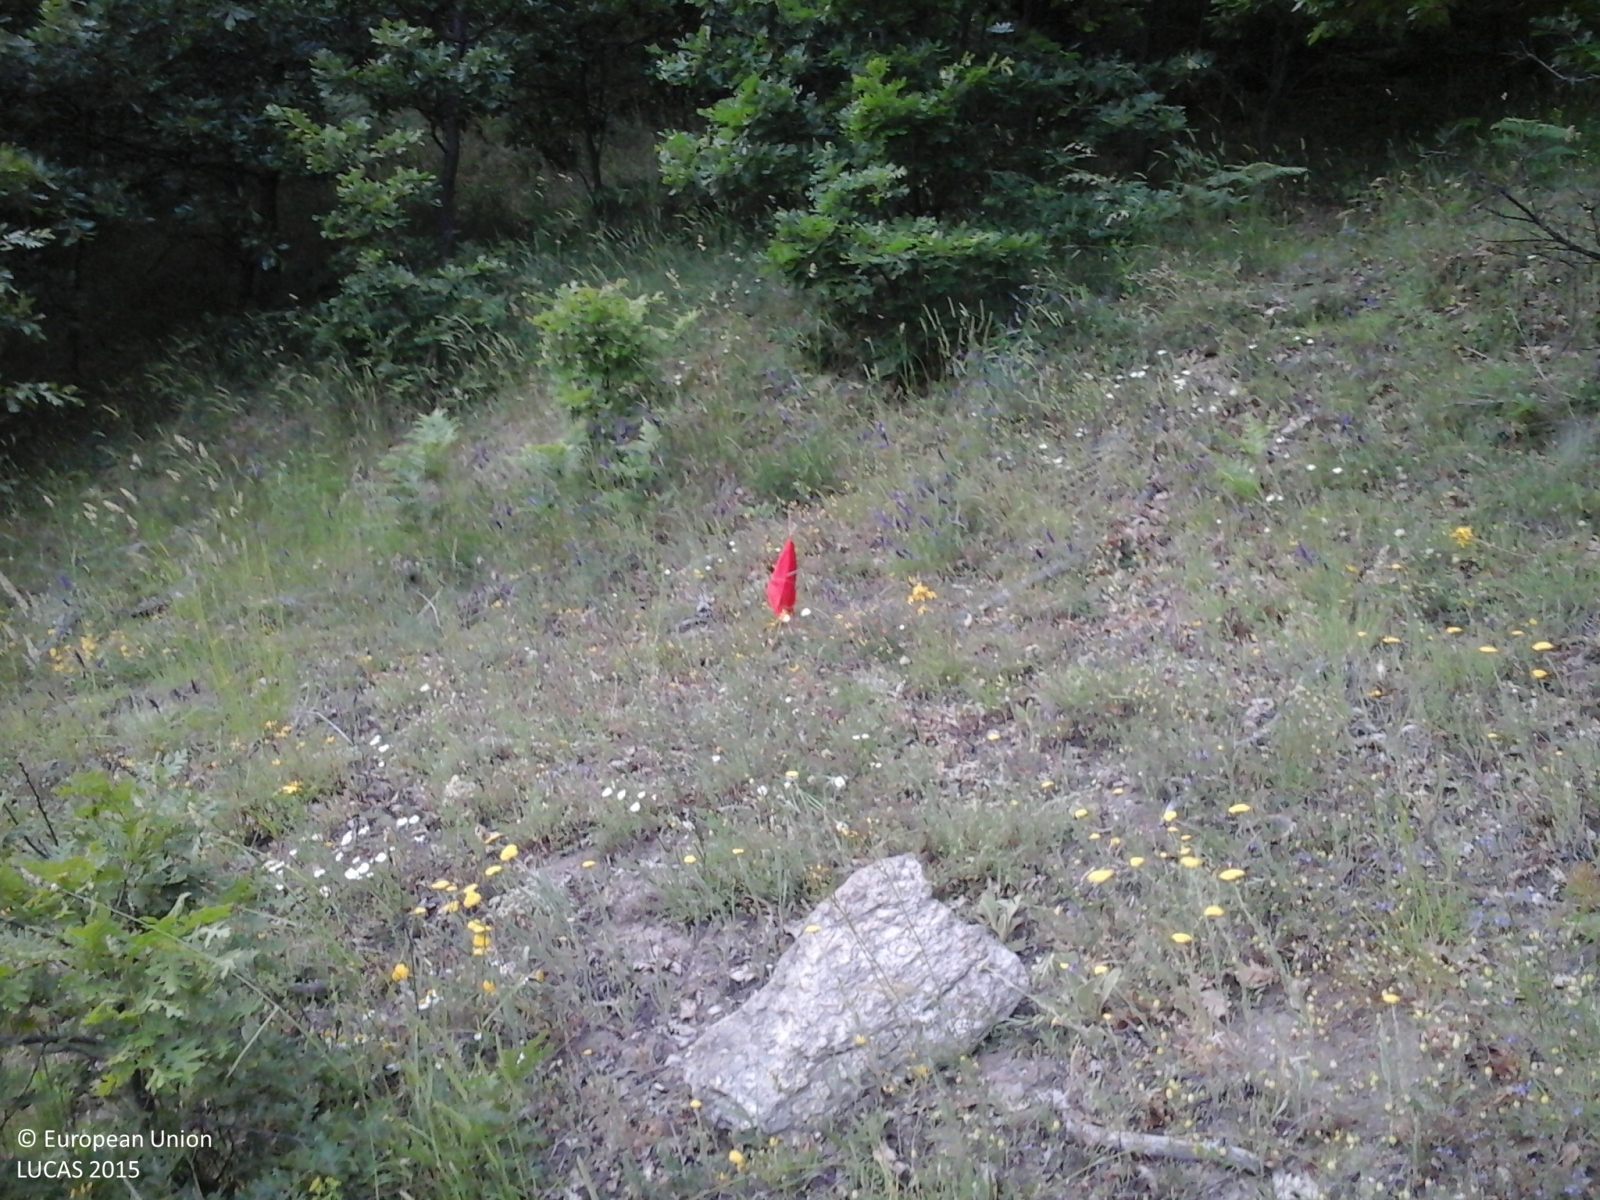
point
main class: Woodland
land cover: Broadleaved woodland
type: thermophilous deciduous forest
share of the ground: 50 - 75 %
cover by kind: broadleaved forest trees 50 %, herbaceous plants 50 %
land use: Forestry
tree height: > 5 m
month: June
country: GR
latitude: 40.6074
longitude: 21.3731
